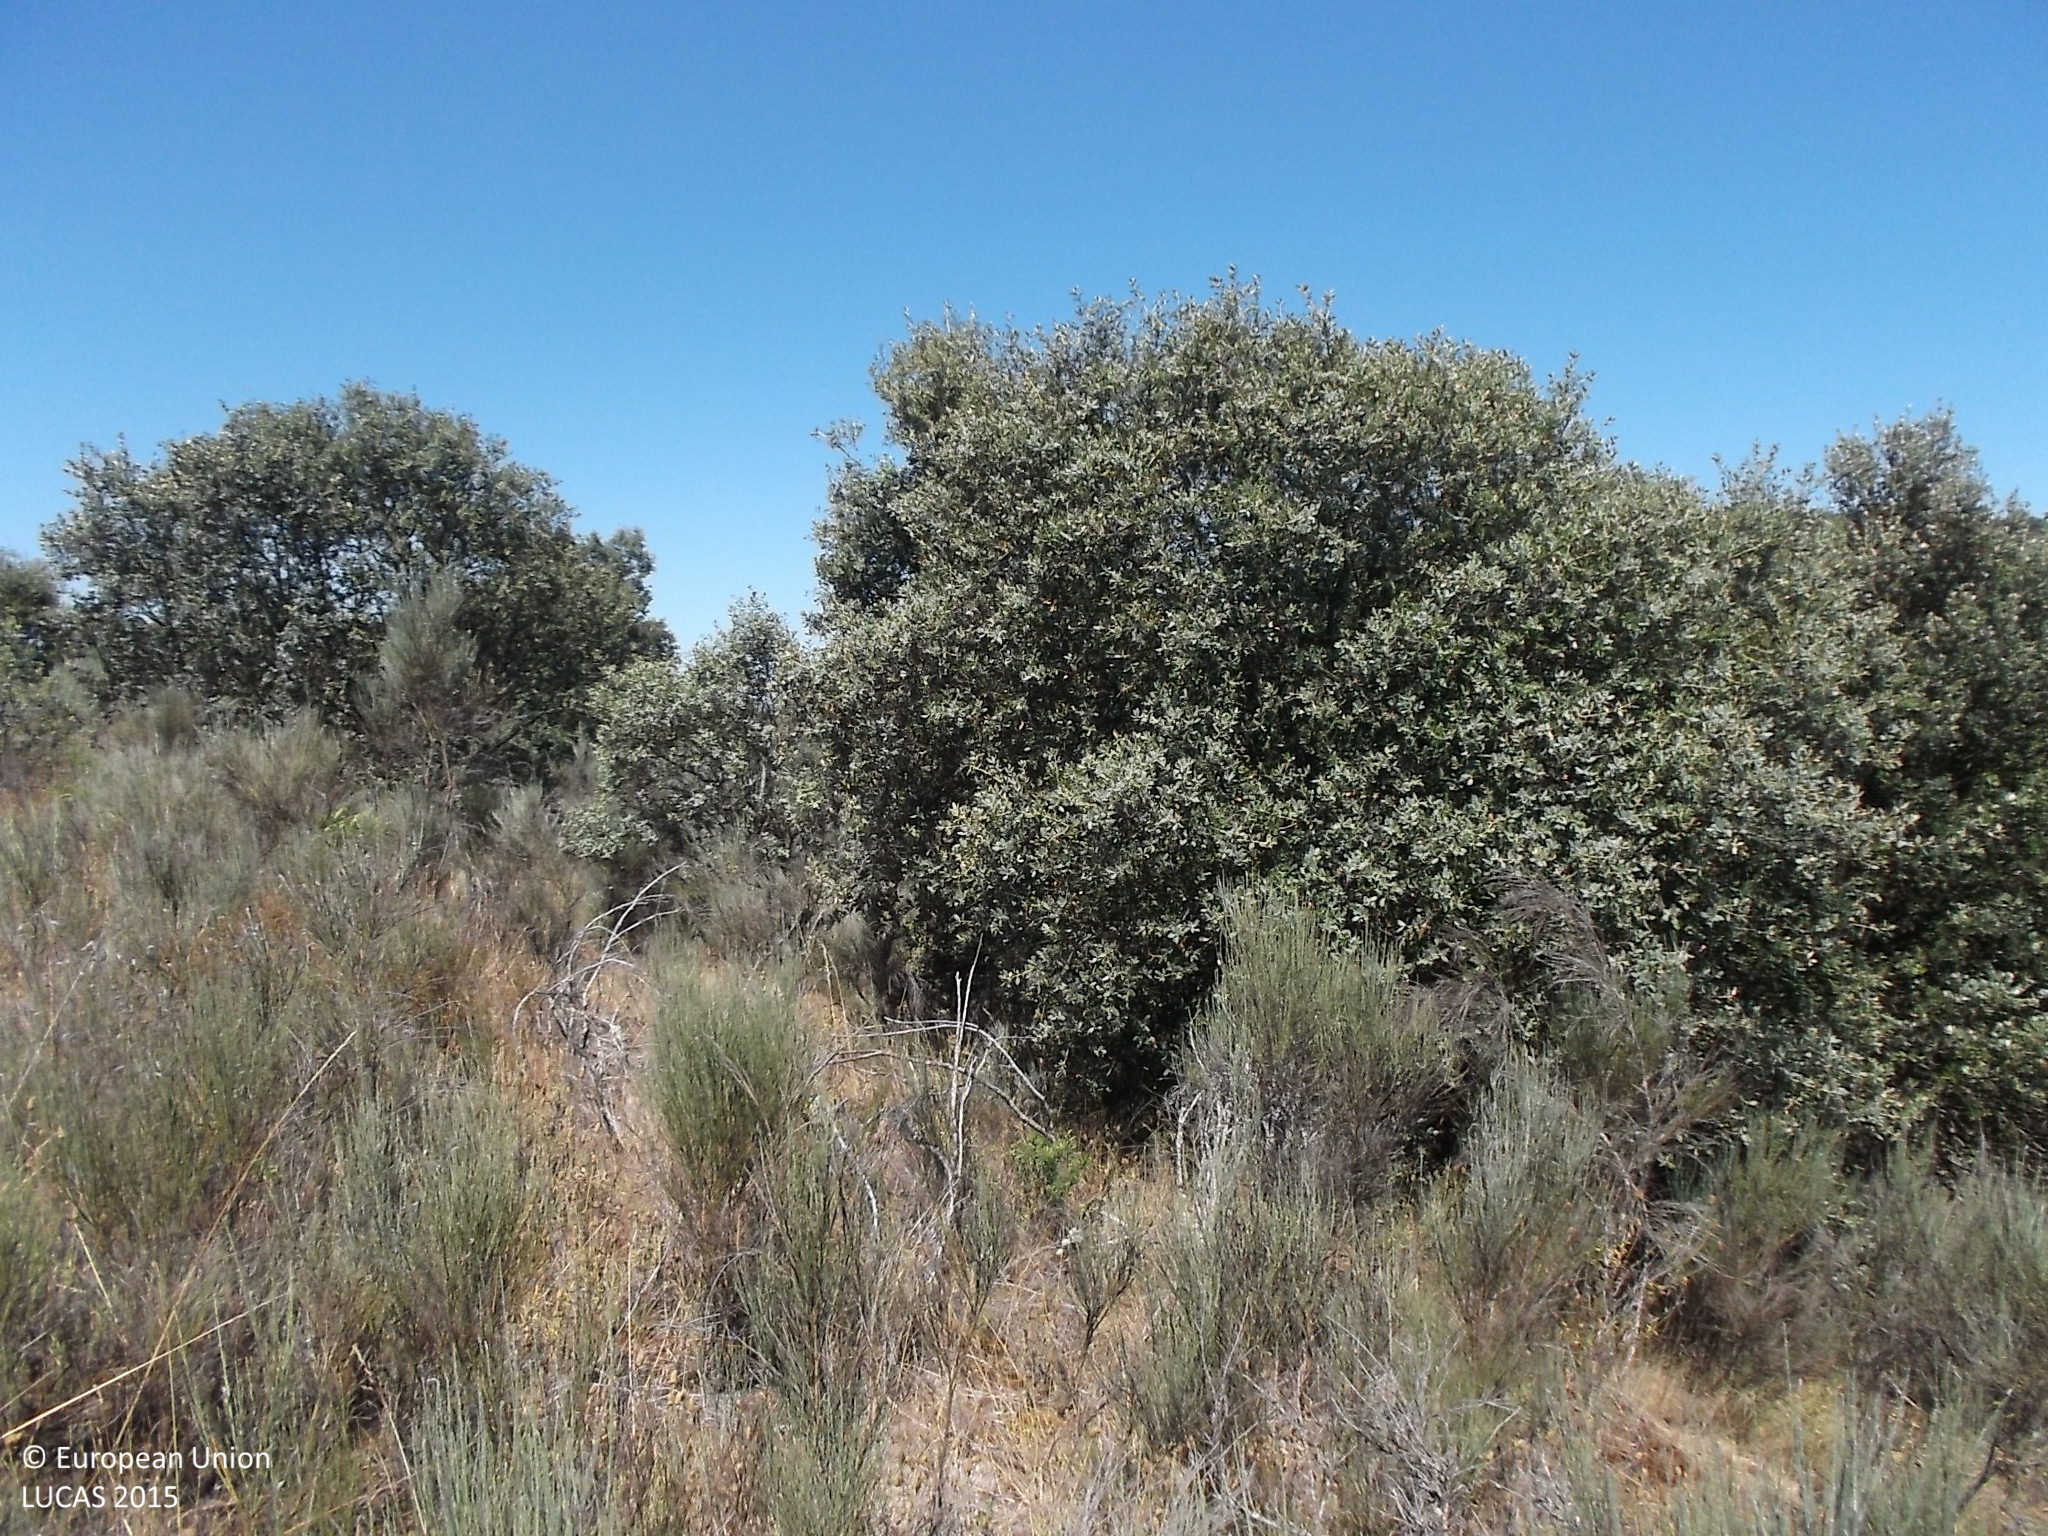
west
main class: Shrubland
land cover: Shrubland with sparse tree cover
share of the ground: > 75 %
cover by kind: shrubs 90 %, broadleaved forest trees 5 %, herbaceous plants 5 %
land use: Abandoned areas
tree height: < 5 m
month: June
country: ES
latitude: 40.8756
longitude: -6.7715
